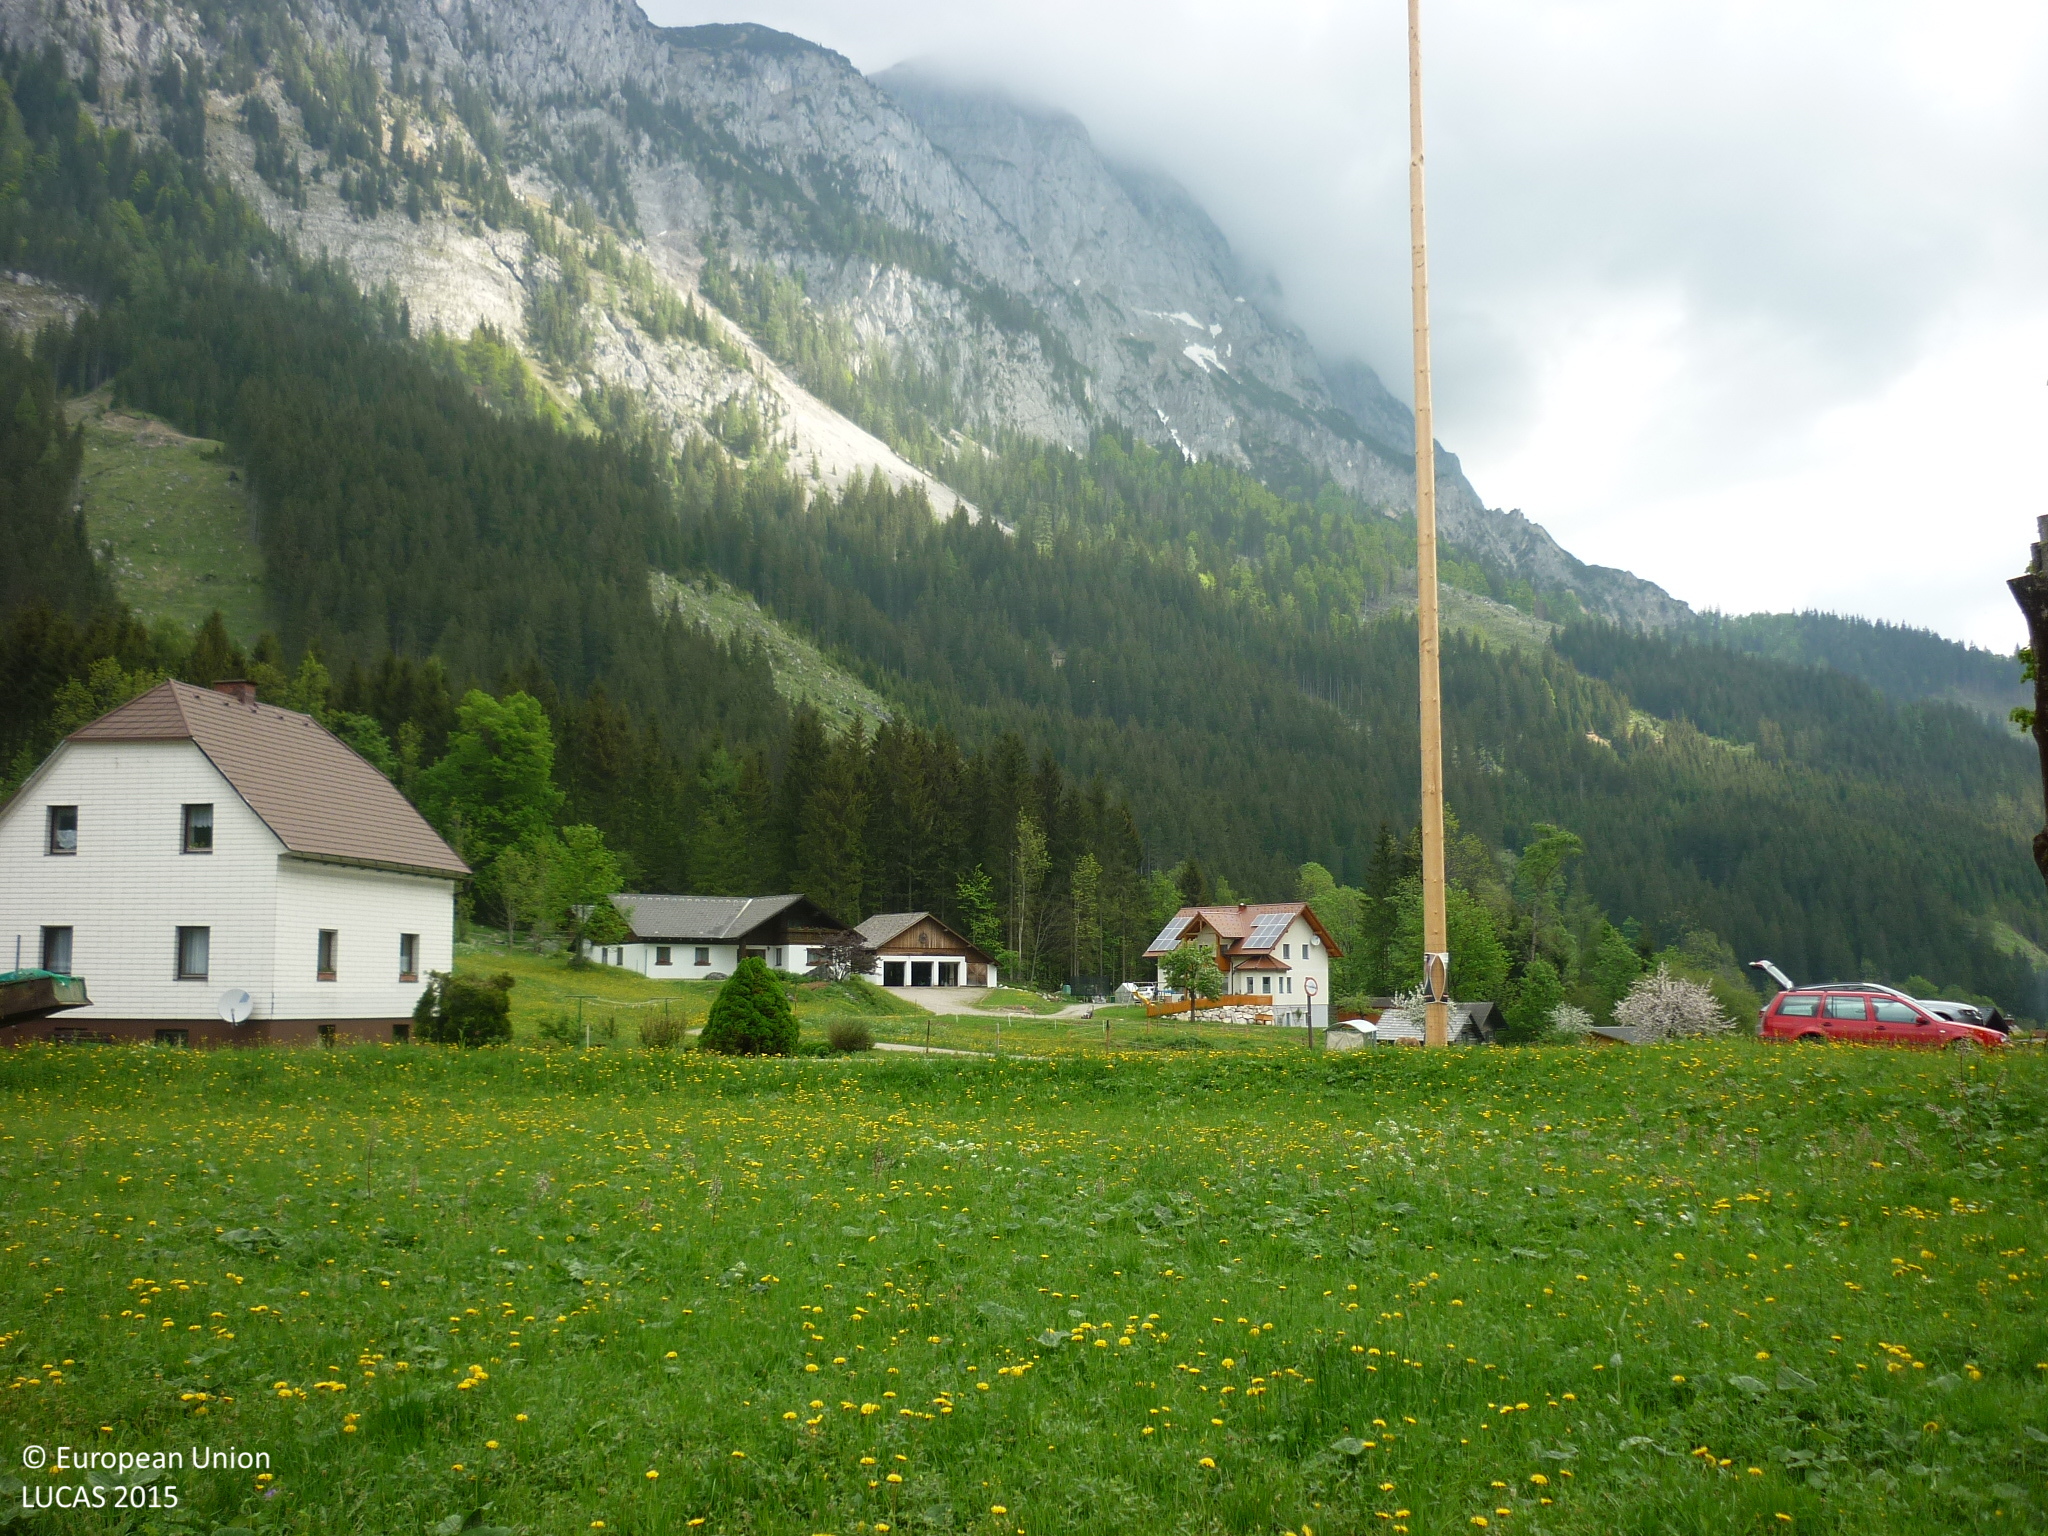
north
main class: Grassland
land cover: Grassland without tree/shrub cover
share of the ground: > 75 %
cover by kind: herbaceous plants 100 %
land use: Agriculture (excluding fallow land and kitchen gardens)
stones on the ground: < 10 %
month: May
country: AT
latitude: 47.5278
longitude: 14.7147
